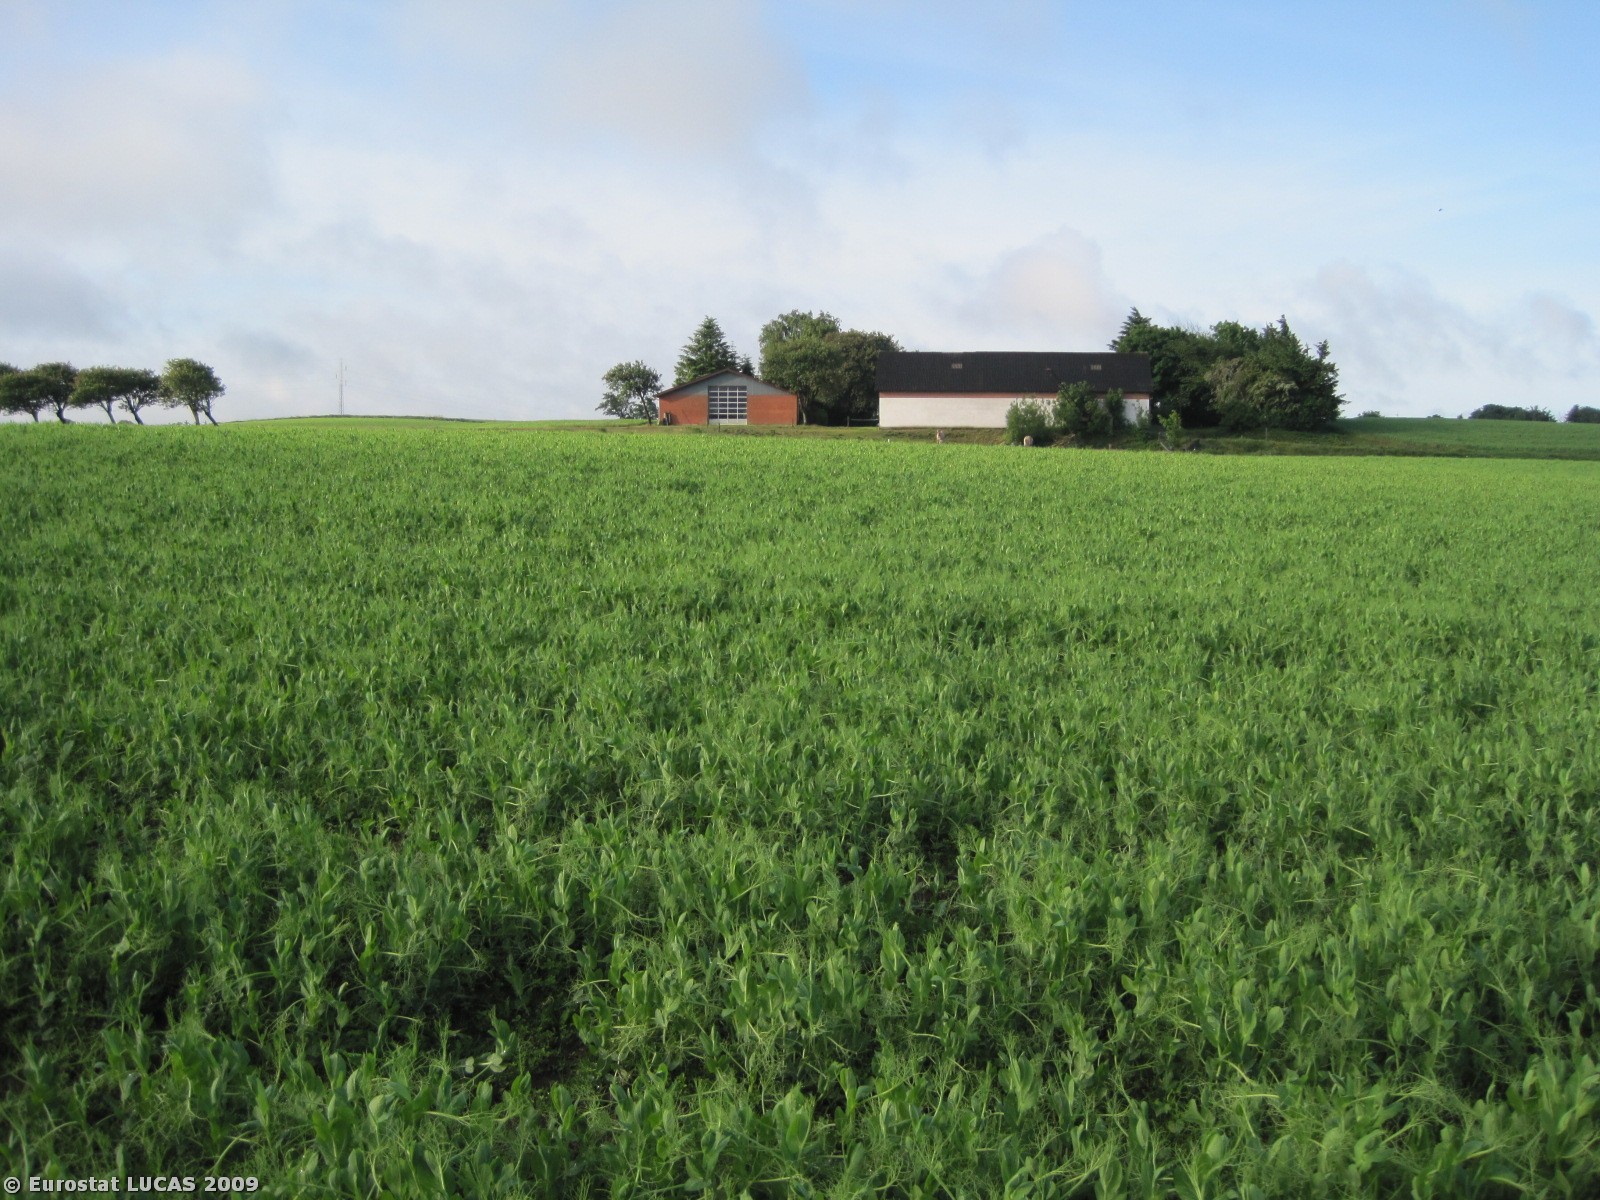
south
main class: Cropland
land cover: Dry pulses
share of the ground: 50 - 75 %
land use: Agriculture (excluding fallow land and kitchen gardens)
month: June
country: DK
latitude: 57.3382
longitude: 10.1493
